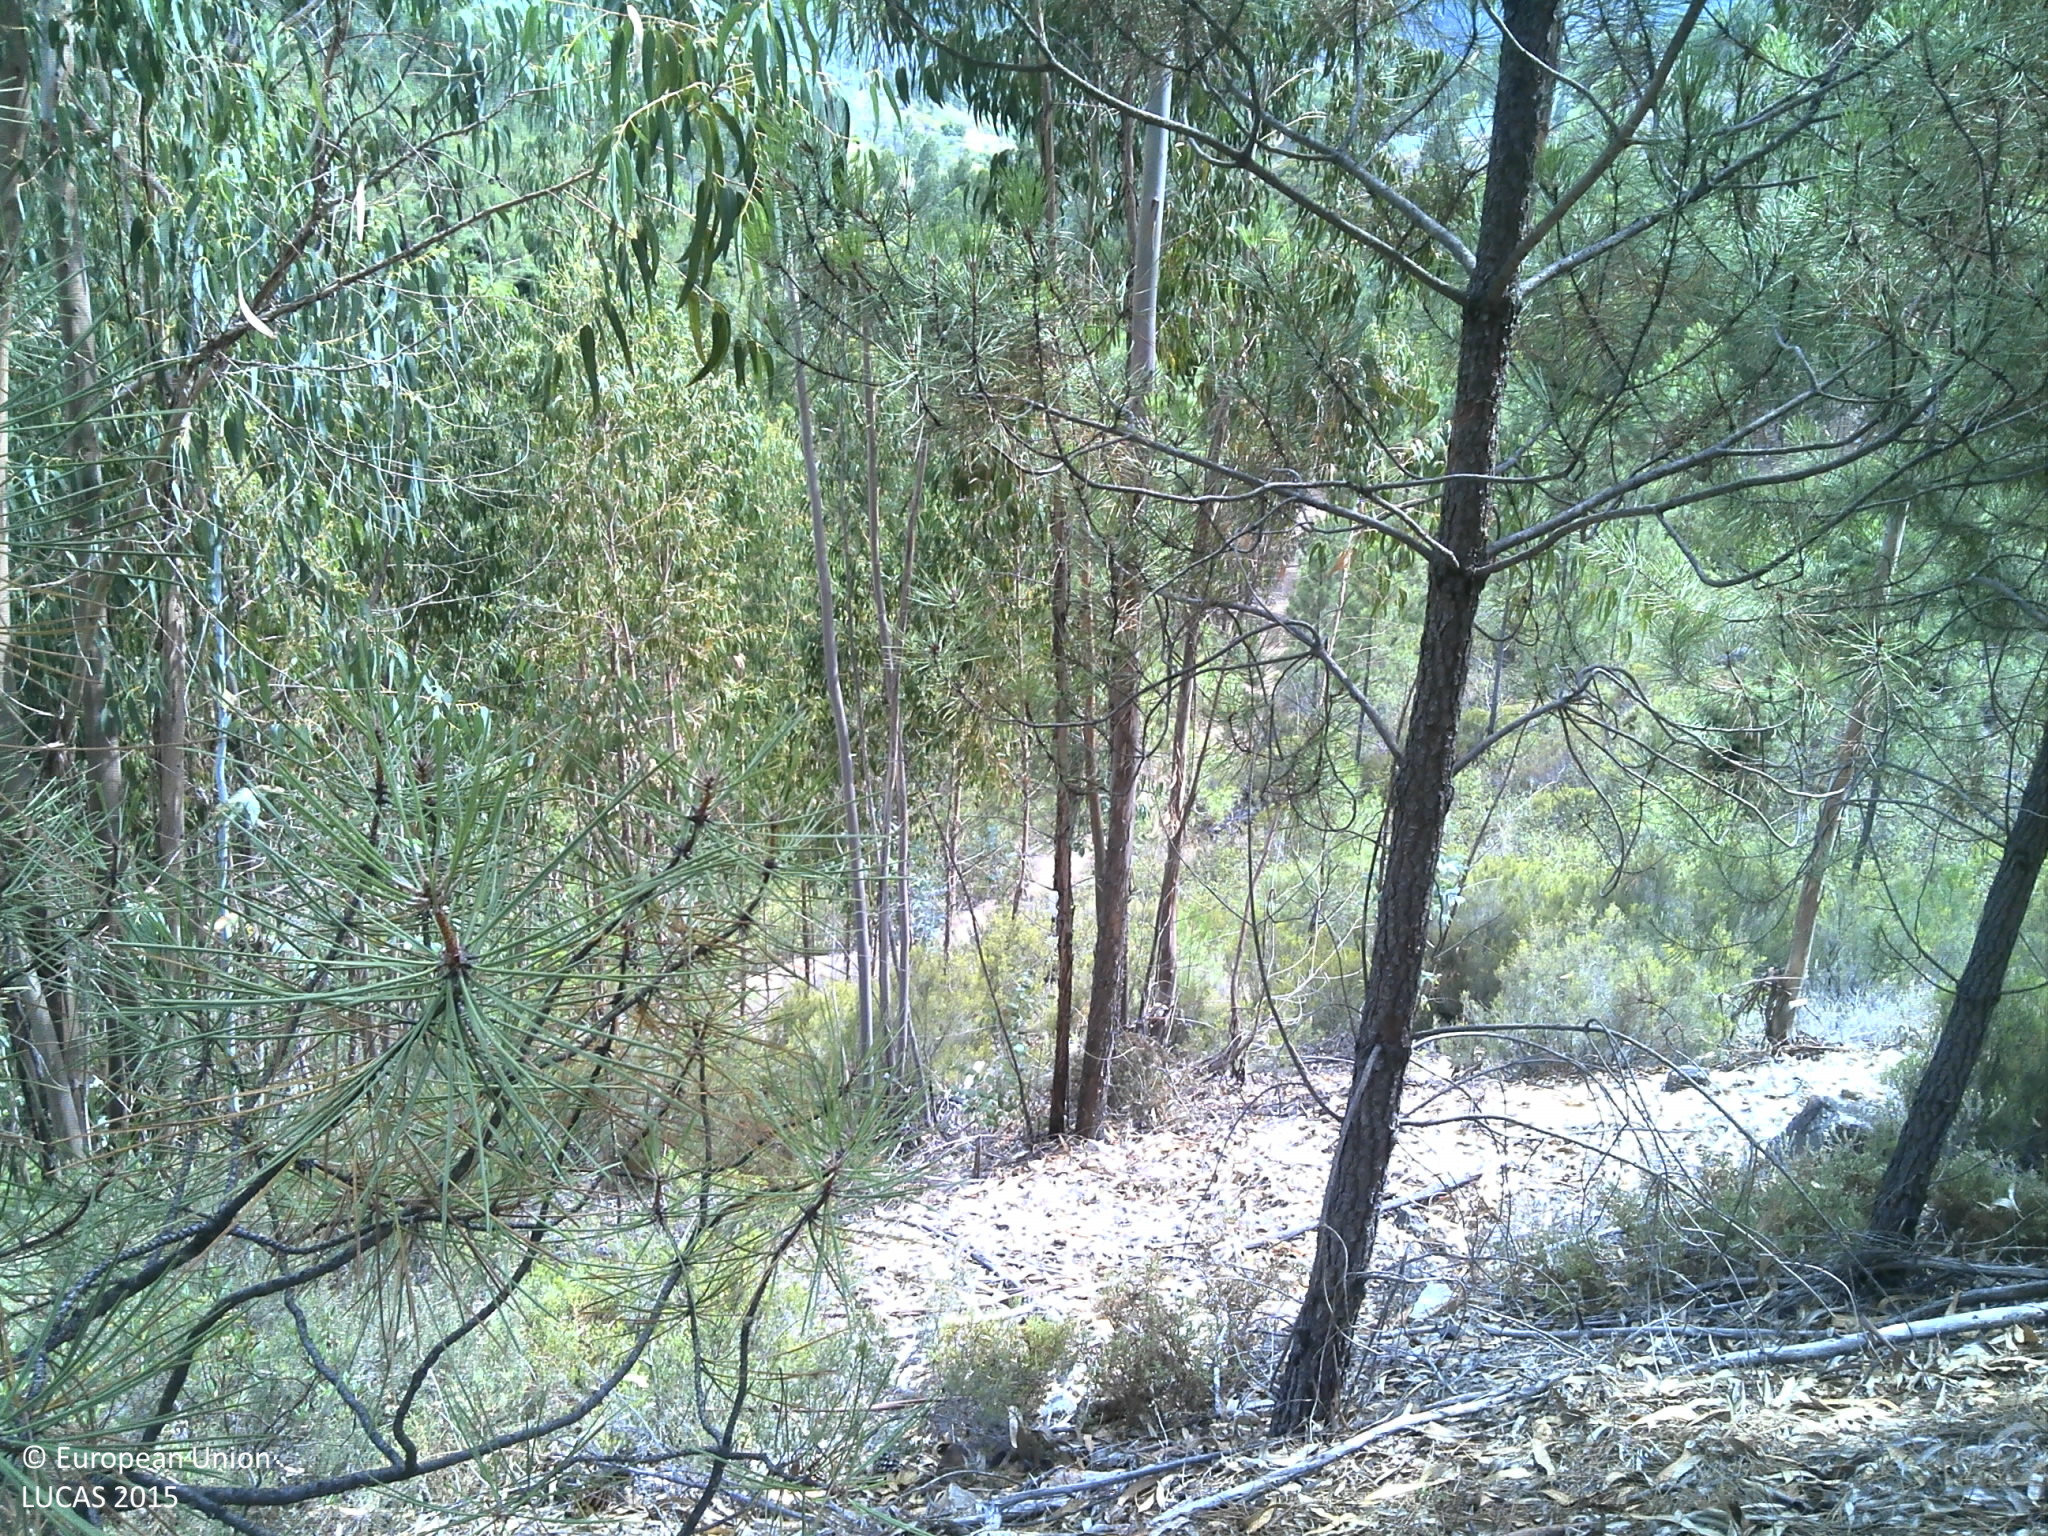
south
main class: Woodland
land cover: Pine dominated mixed woodland
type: coniferous forest of the mediterranean region
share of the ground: 25 - 50 %
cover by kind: shrubs 30 %, unconsolidated bare surface 25 %, consolidated bare surface 20 %, broadleaved forest trees 15 %, coniferous forest trees 10 %
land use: Forestry
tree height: > 5 m
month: July
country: PT
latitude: 39.6153
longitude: -8.0354
